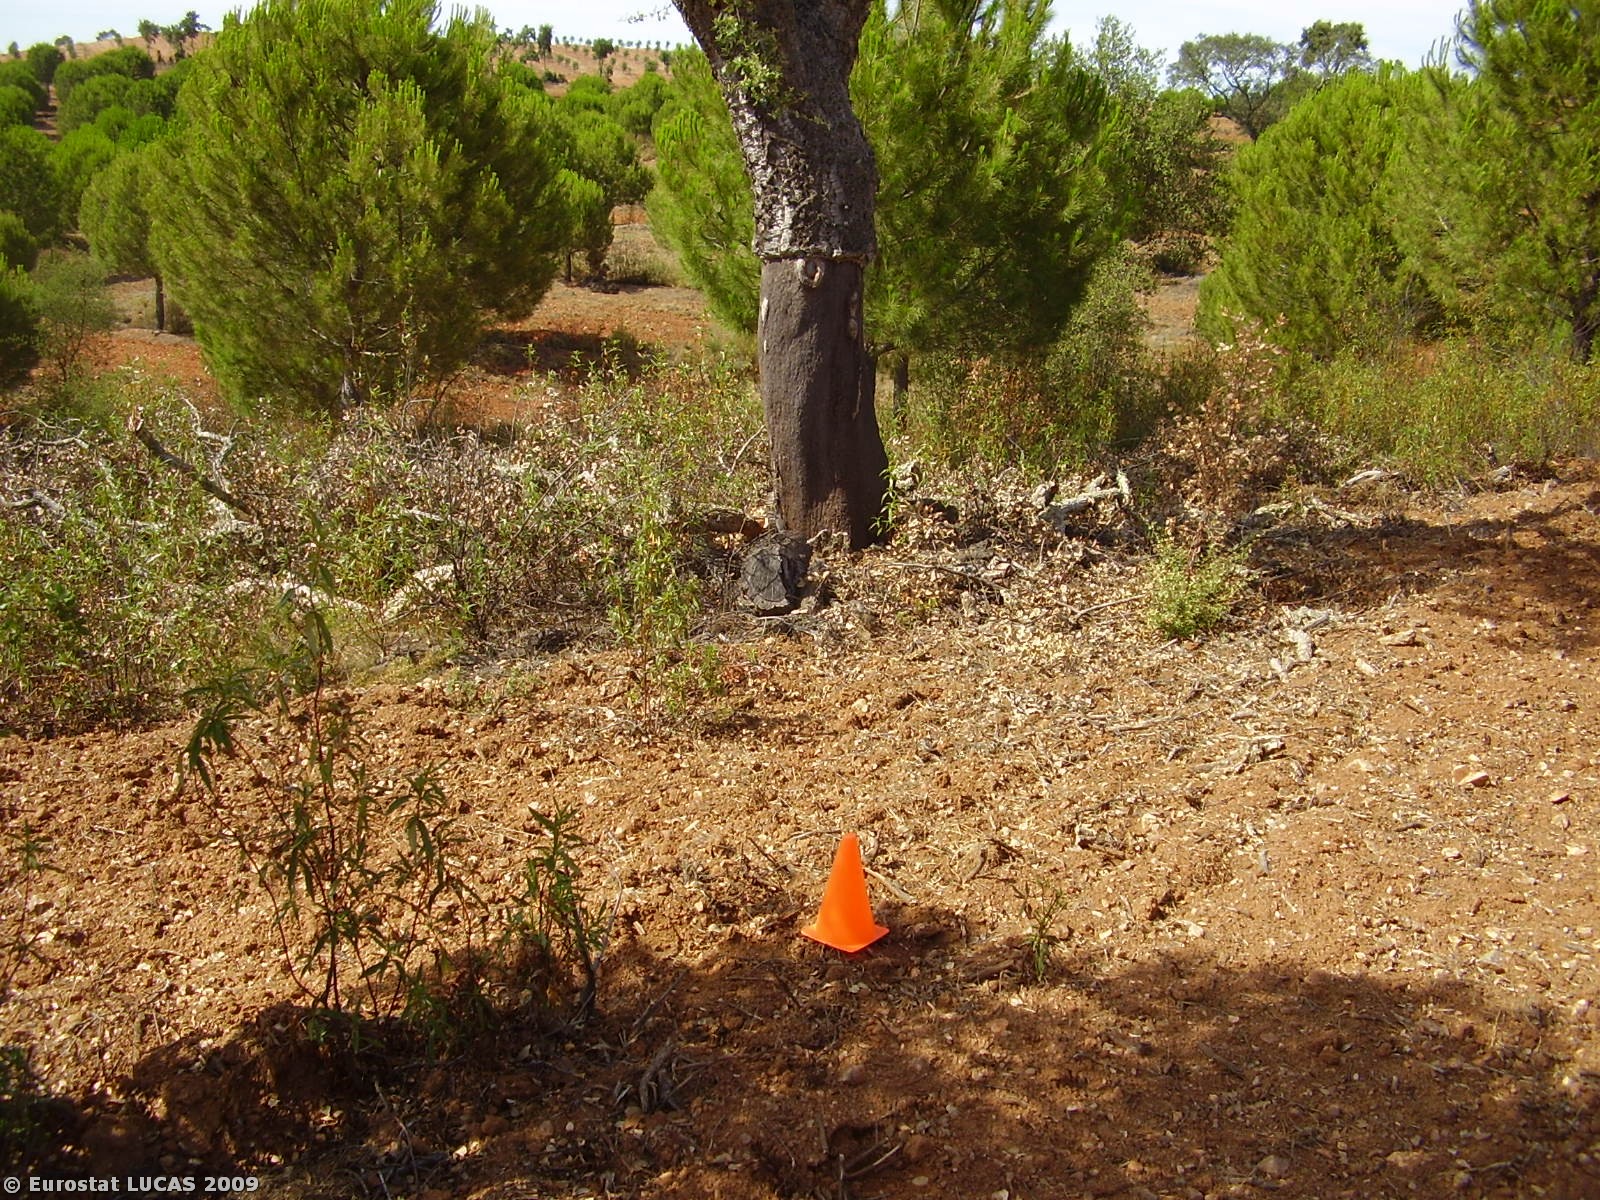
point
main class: Woodland
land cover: Coniferous woodland
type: coniferous forest of the mediterranean region
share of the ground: 10 - 25 %
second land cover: Bare land
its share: 50 - 75 %
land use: Forestry
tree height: > 5 m
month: July
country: PT
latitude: 38.5615
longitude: -7.7431
